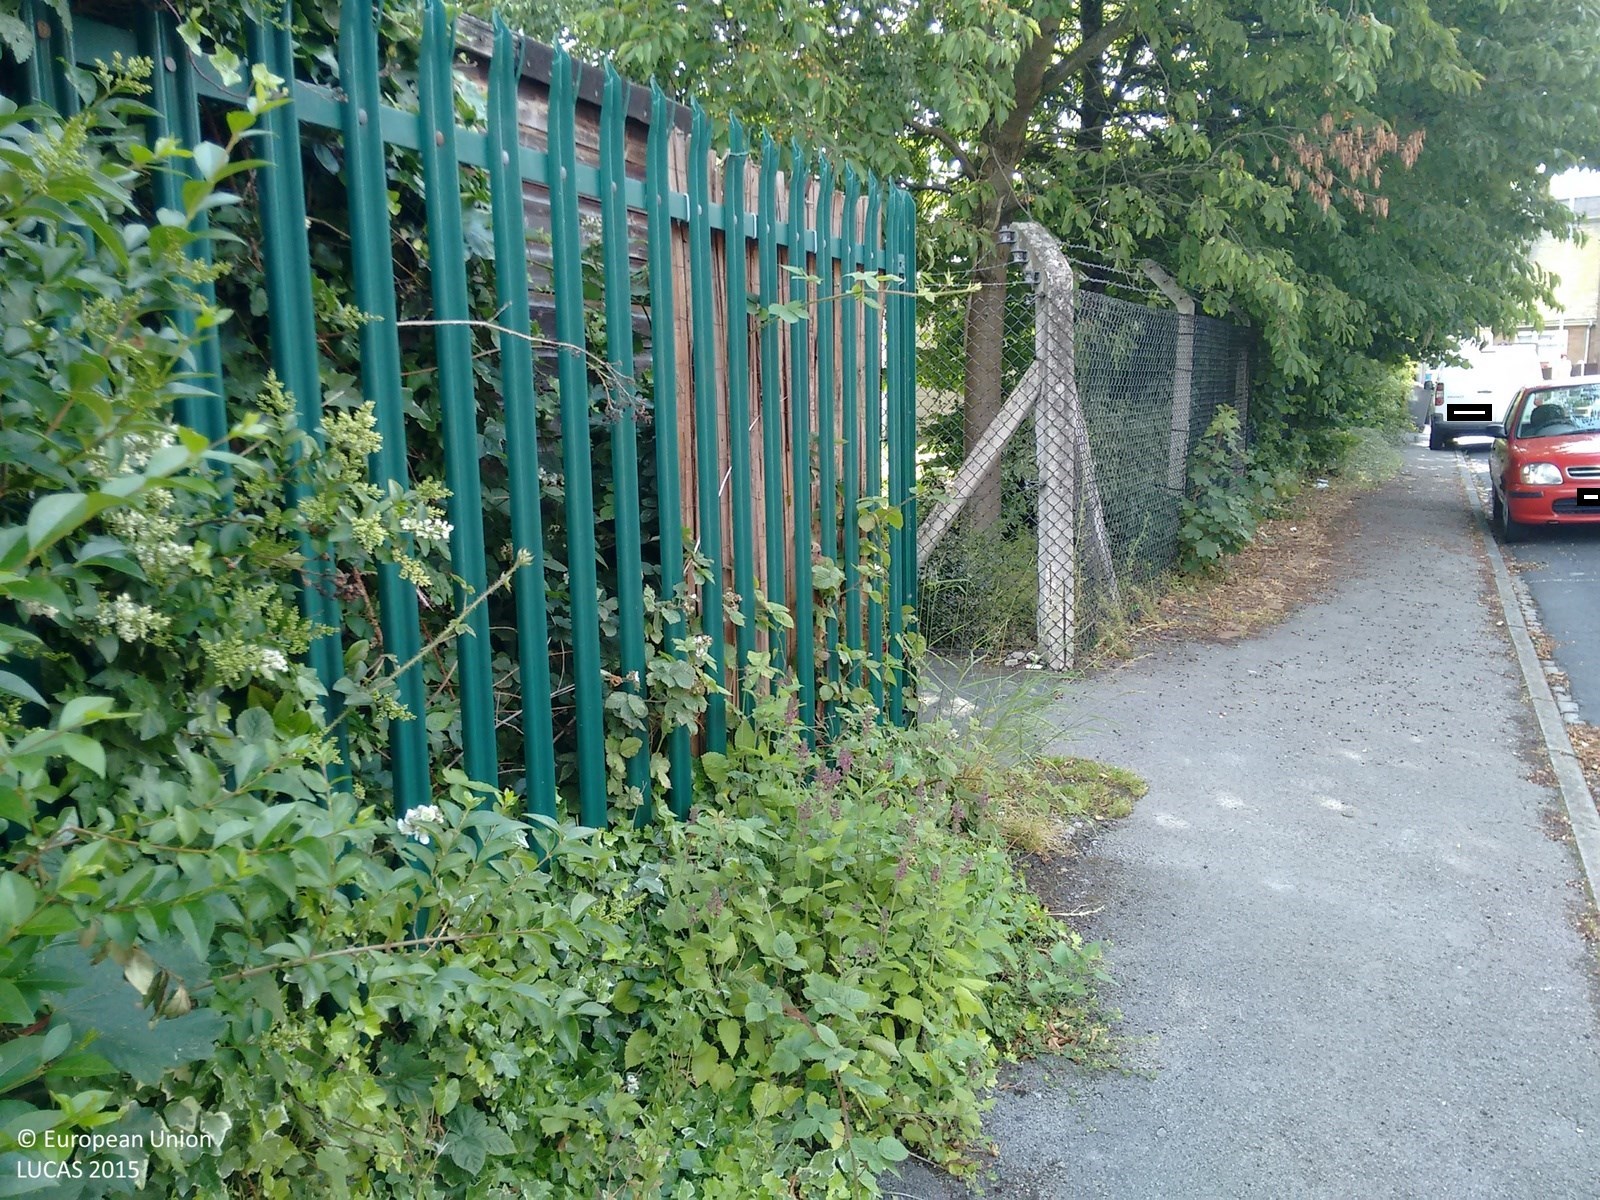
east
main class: Grassland
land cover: Grassland without tree/shrub cover
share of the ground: > 75 %
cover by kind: herbaceous plants 100 %
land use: Residential
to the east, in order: Grassland without tree/shrub cover; Artificial constructions in urban areas
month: July
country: GB
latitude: 52.9883
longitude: -2.1413
